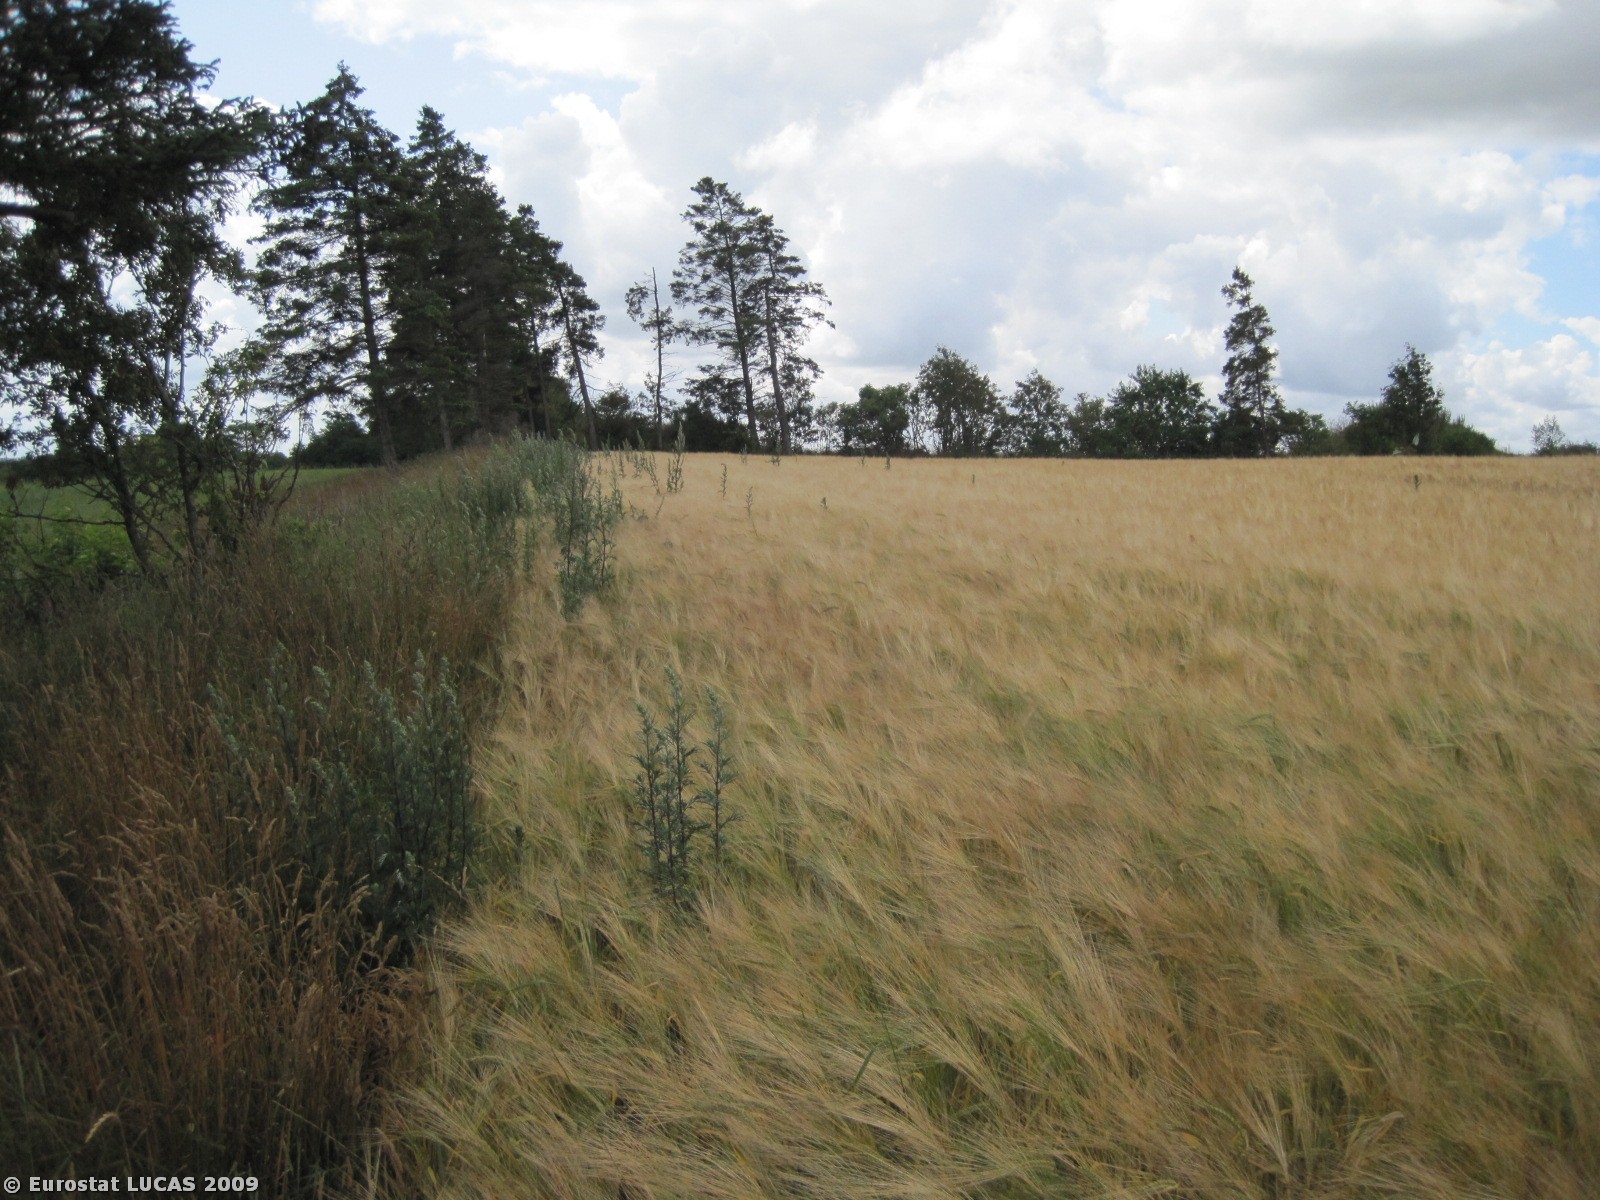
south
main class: Cropland
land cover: Barley
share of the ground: > 75 %
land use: Agriculture (excluding fallow land and kitchen gardens)
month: July
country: DK
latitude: 56.3804
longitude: 8.8516
